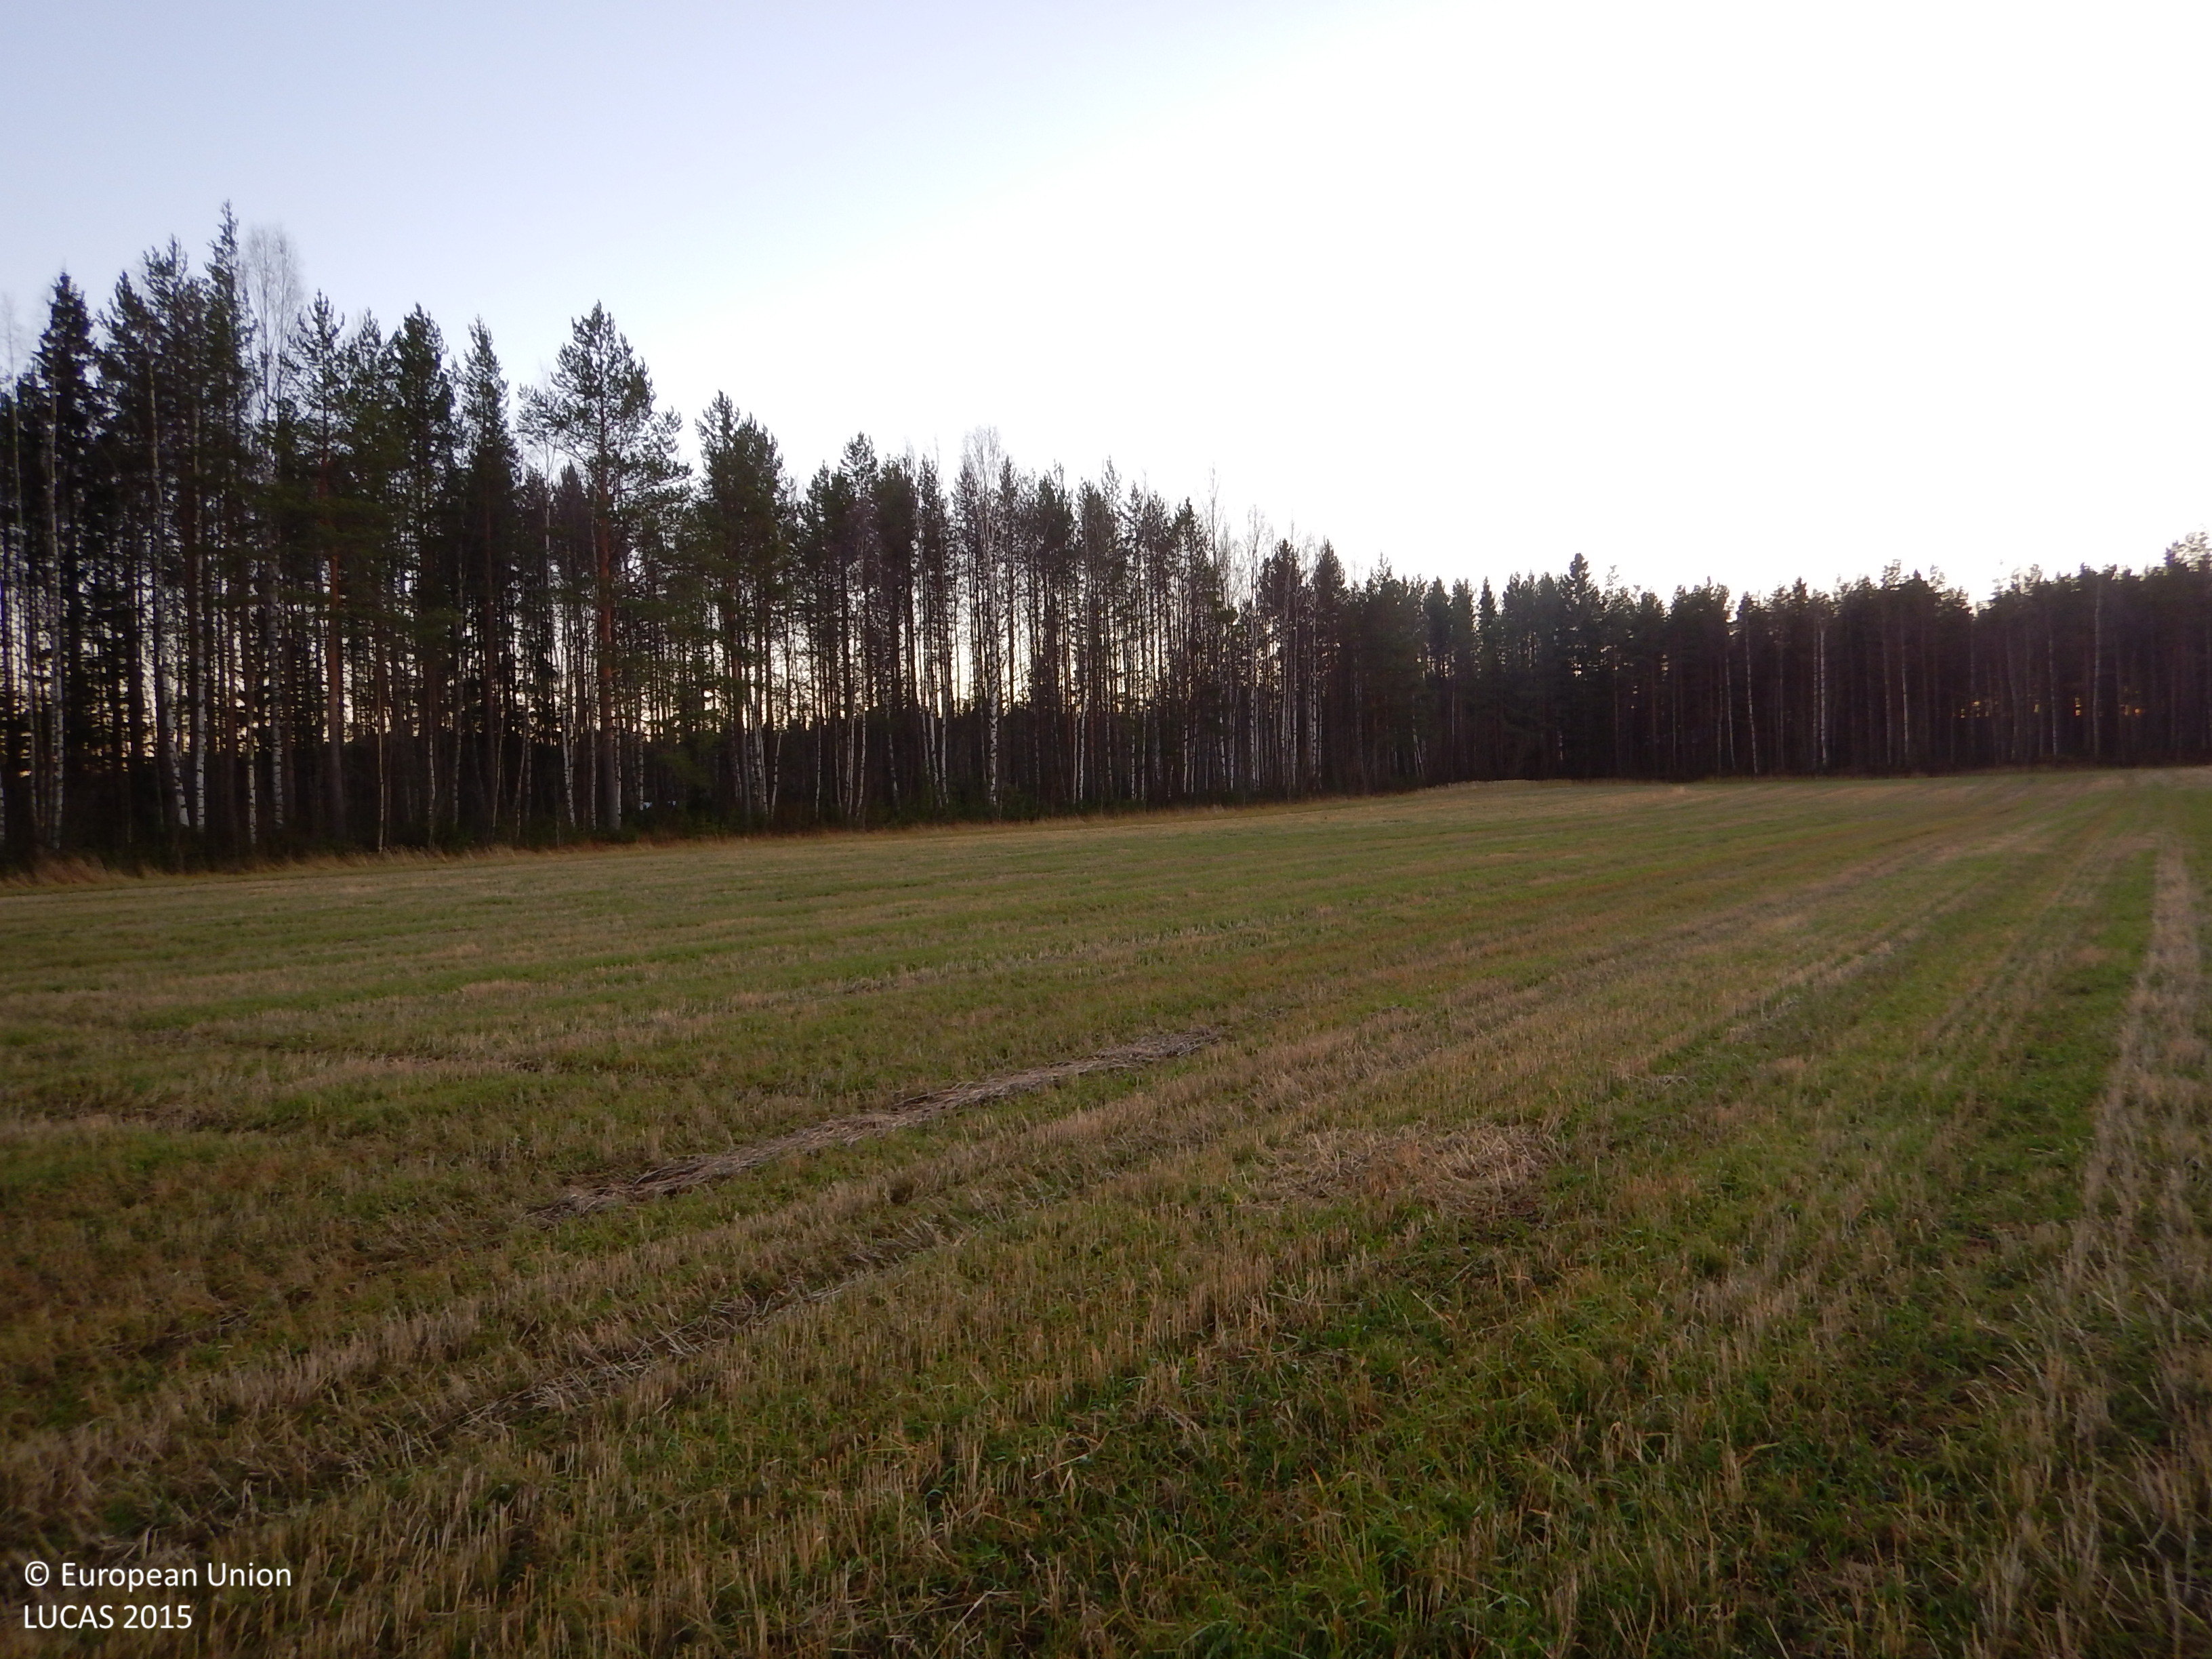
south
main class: Cropland
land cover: Temporary grasslands
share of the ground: > 75 %
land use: Agriculture (excluding fallow land and kitchen gardens)
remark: Harvested field
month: November
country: SE
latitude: 65.3351
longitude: 21.2057
